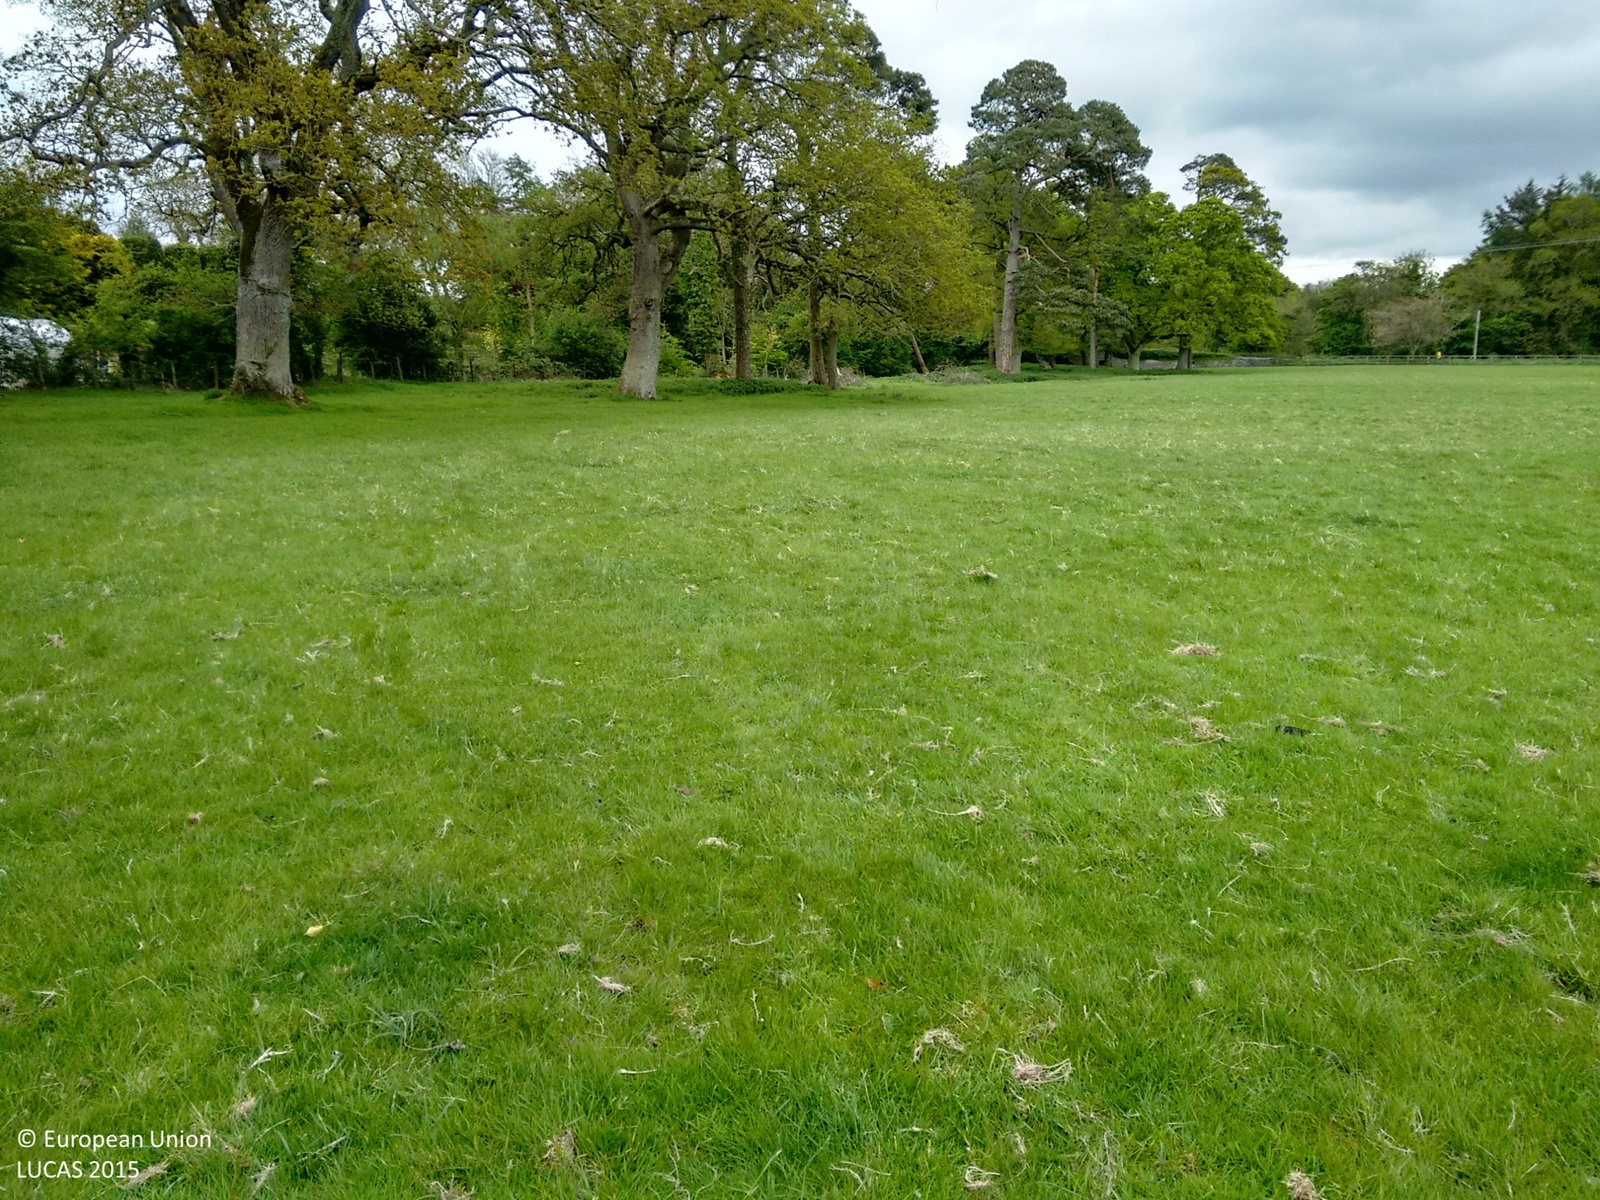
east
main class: Grassland
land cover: Grassland without tree/shrub cover
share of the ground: > 75 %
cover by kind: herbaceous plants 95 %, unconsolidated bare surface 5 %
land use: Agriculture (excluding fallow land and kitchen gardens)
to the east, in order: Grassland without tree/shrub cover; Other mixed woodland; Rivers and streams; Other mixed woodland; Artificial constructions in urban areas; Grass margins; Managed hedges; Barley
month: May
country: IE
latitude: 53.2375
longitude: -6.5962
